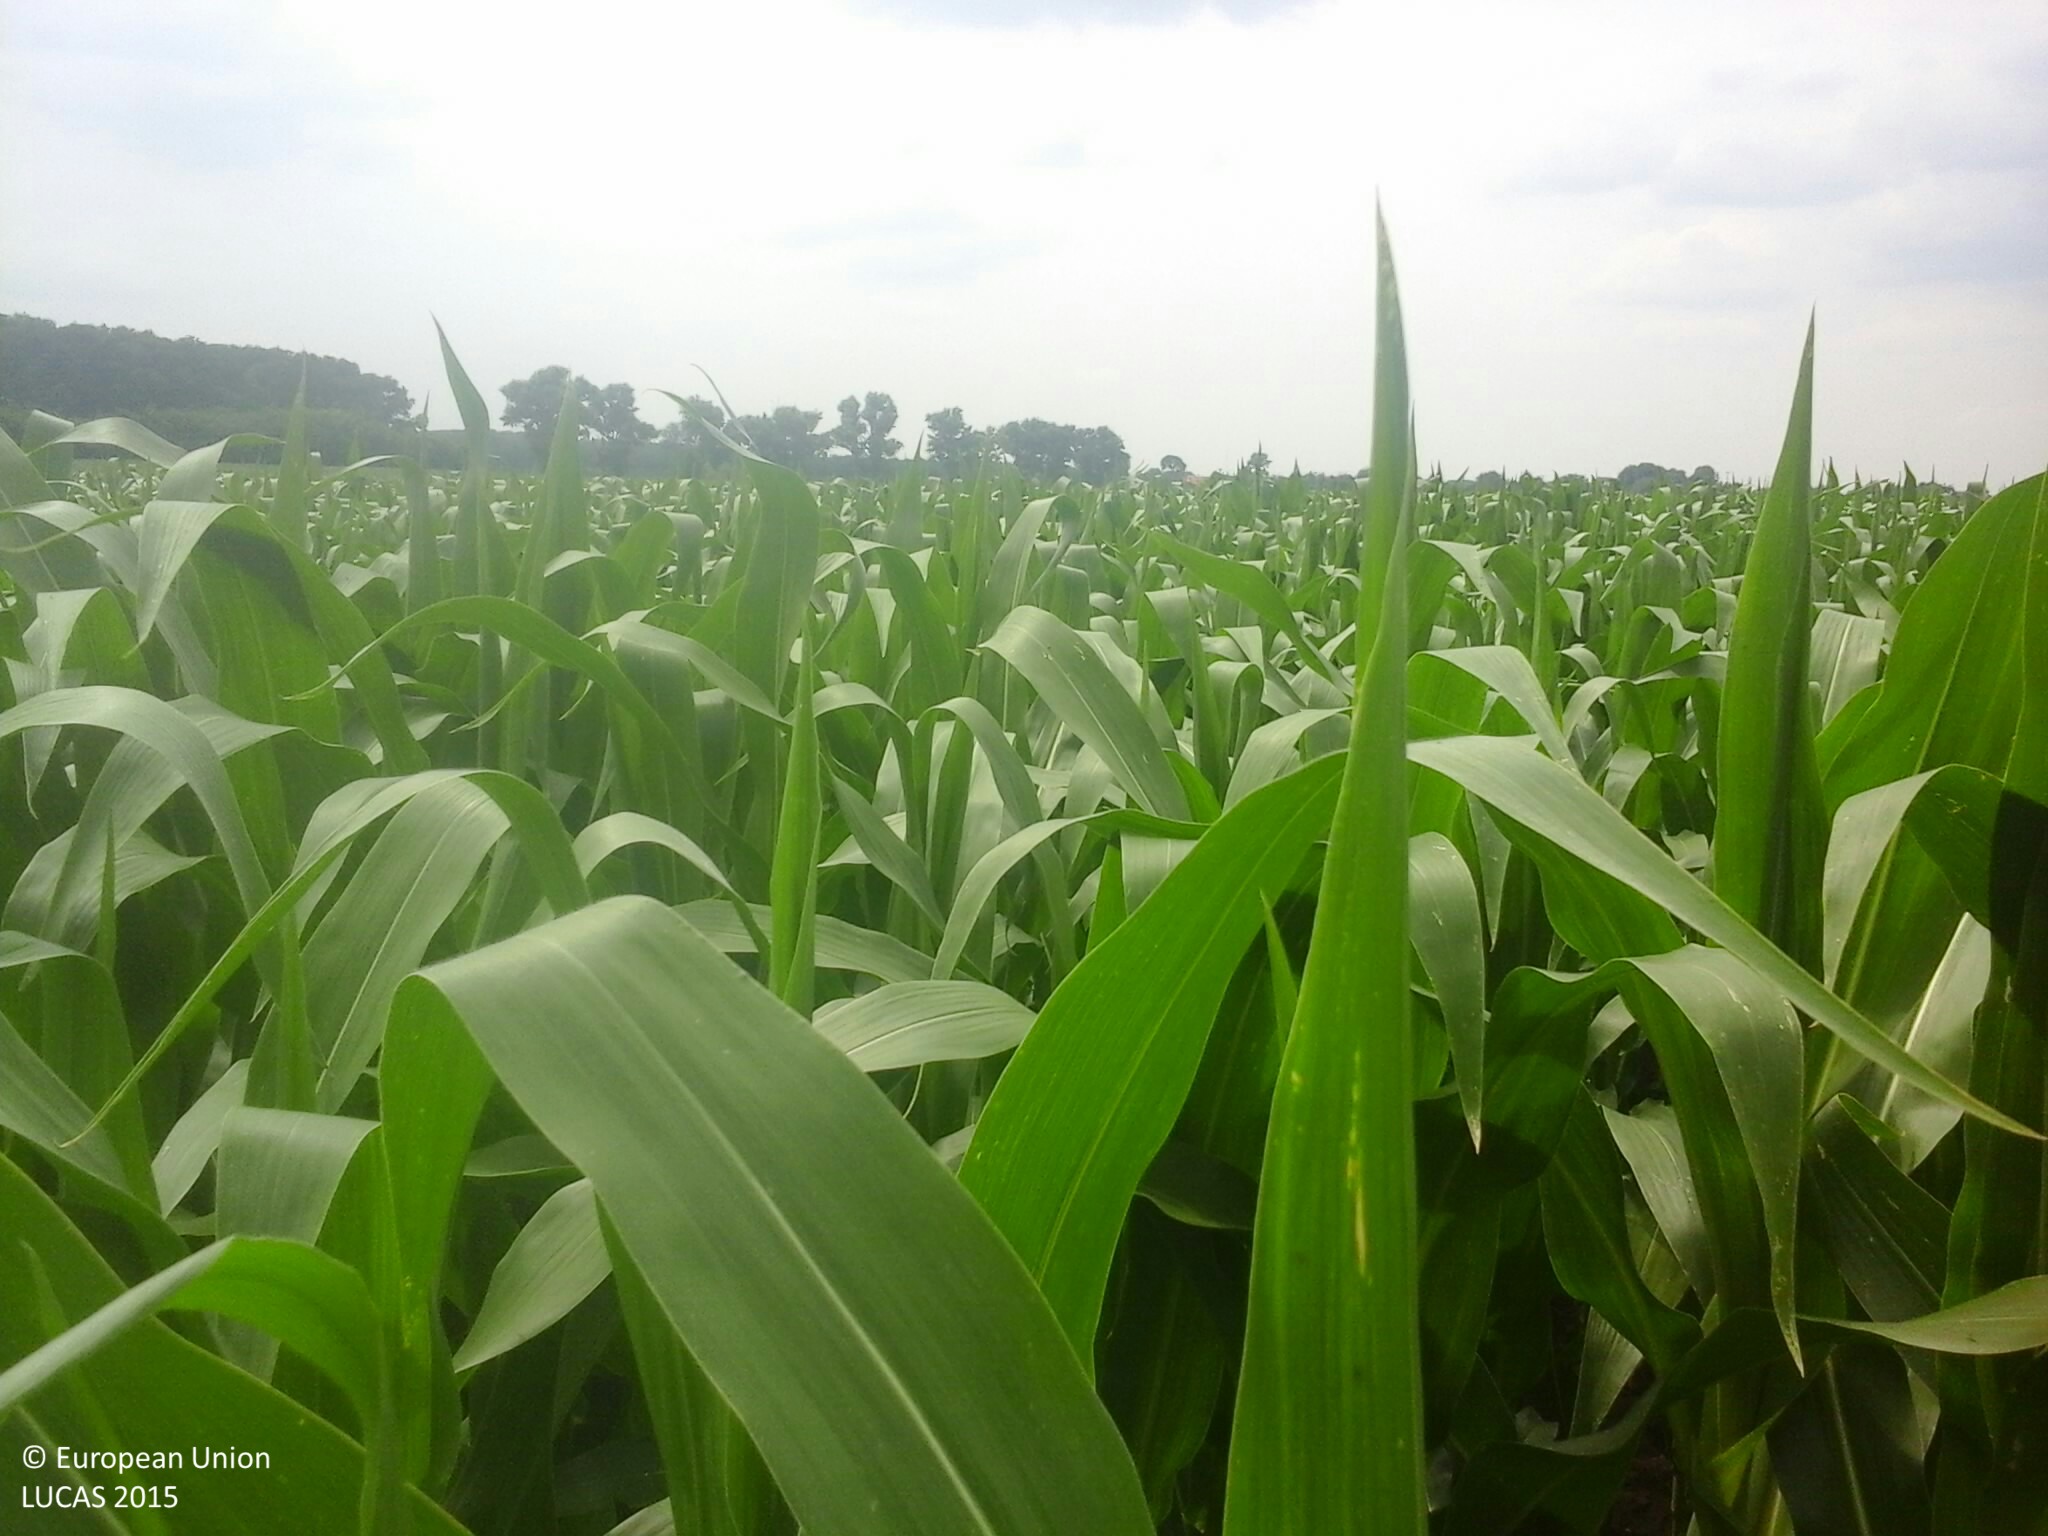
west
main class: Cropland
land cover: Maize
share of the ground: > 75 %
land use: Agriculture (excluding fallow land and kitchen gardens)
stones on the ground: < 10 %
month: June
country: HU
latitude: 47.3720
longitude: 19.3562
